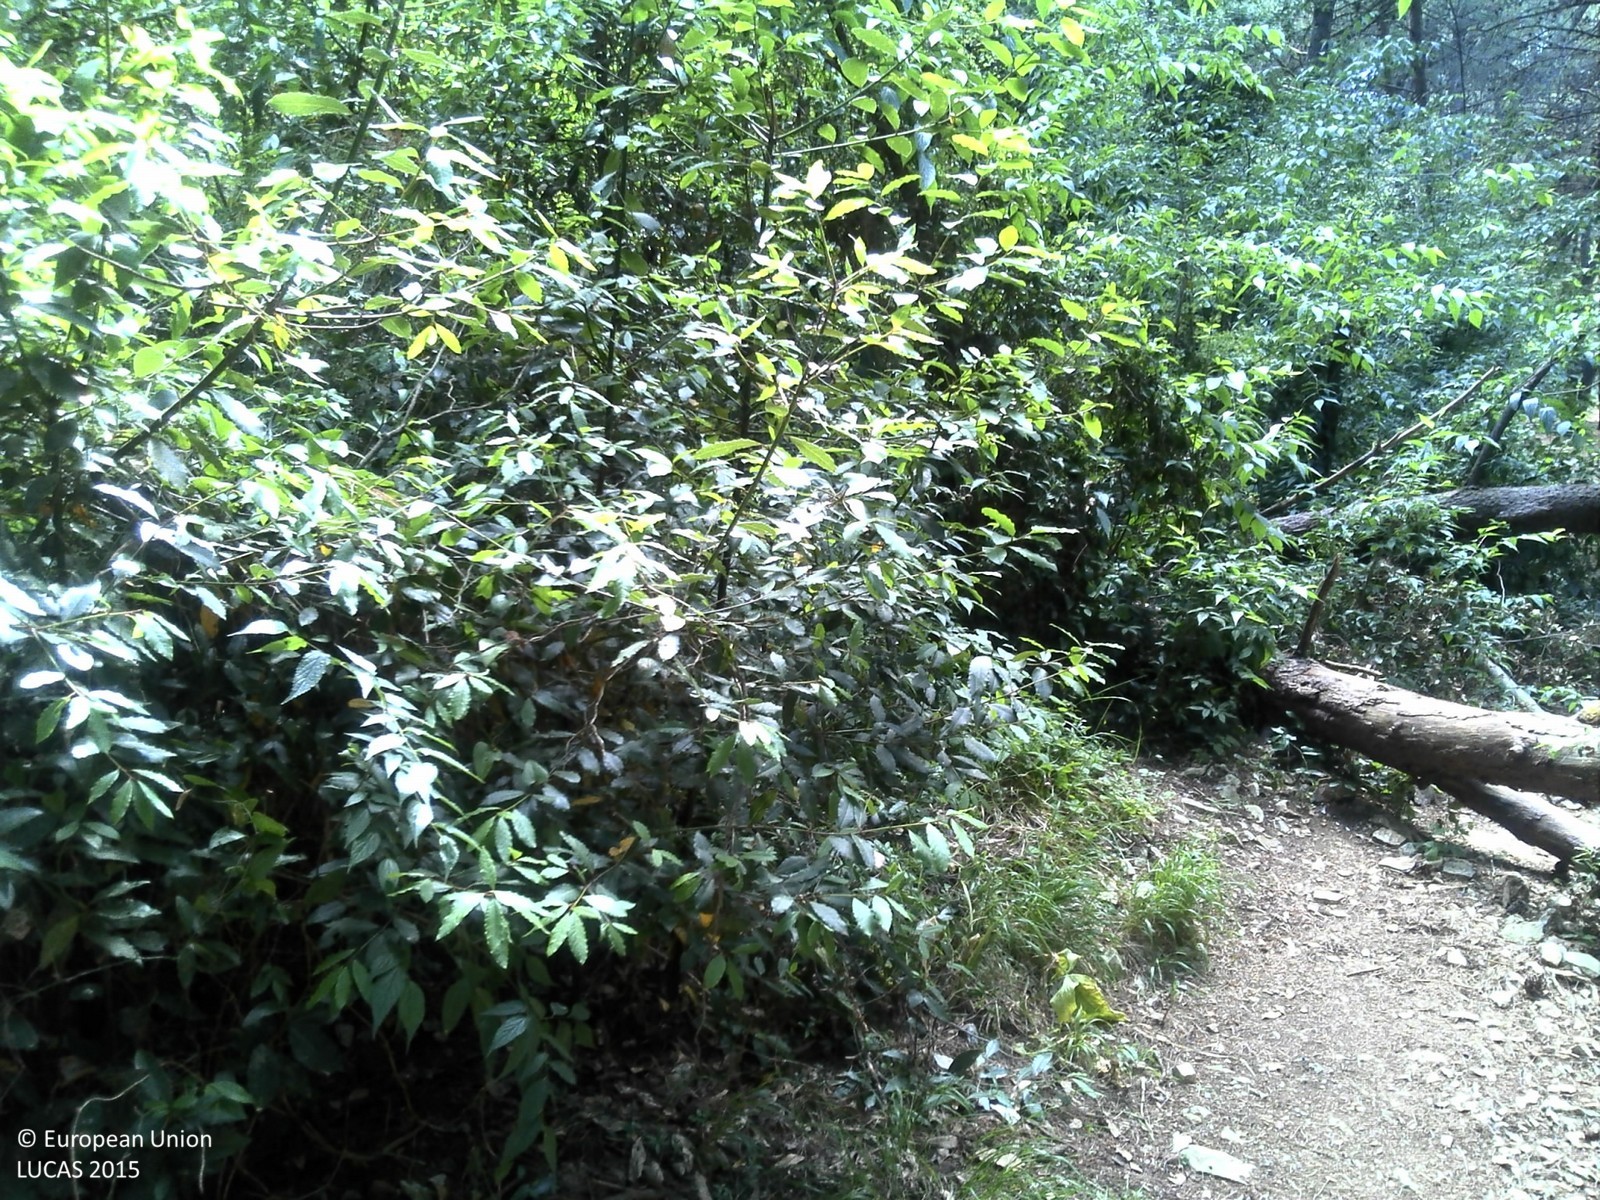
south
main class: Woodland
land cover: Other coniferous woodland
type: coniferous forest of the mediterranean region
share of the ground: > 75 %
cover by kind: coniferous forest trees 85 %, shrubs 10 %, broadleaved forest trees 5 %
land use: Sport
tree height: > 5 m
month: June
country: HR
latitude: 44.8576
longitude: 13.8284
